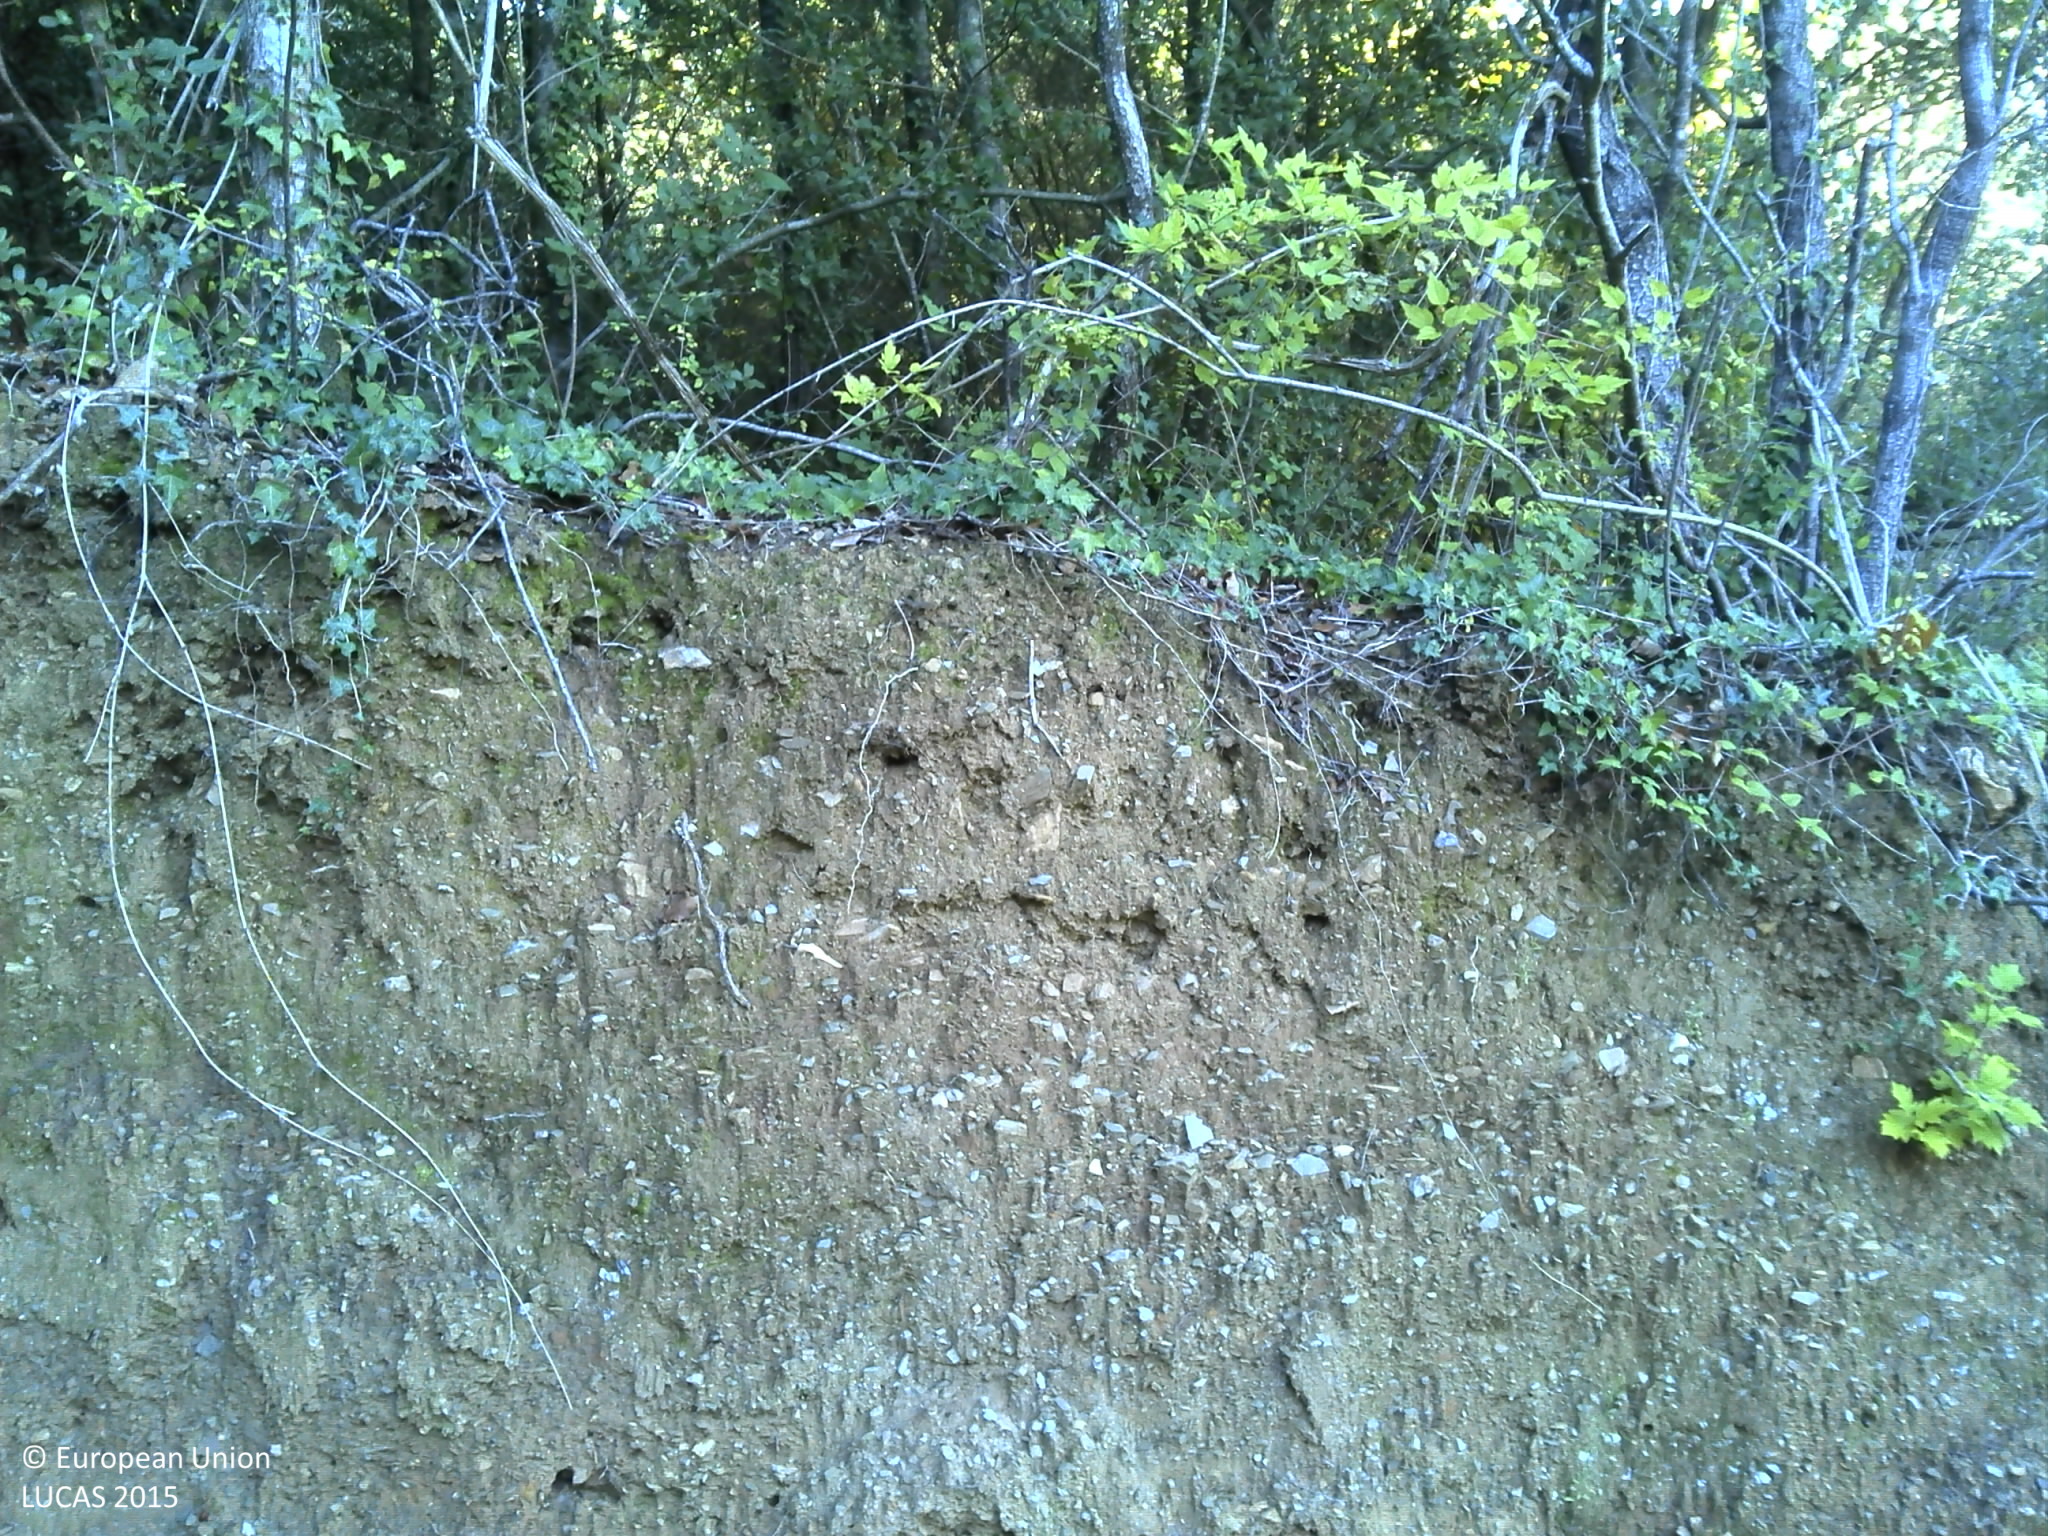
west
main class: Woodland
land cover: Broadleaved woodland
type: mesophytic deciduous forest
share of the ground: > 75 %
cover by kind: broadleaved forest trees 90 %, herbaceous plants 5 %, lichens and mosses 5 %
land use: Forestry
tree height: > 5 m
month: October
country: FR
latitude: 43.5801
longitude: 3.1352
